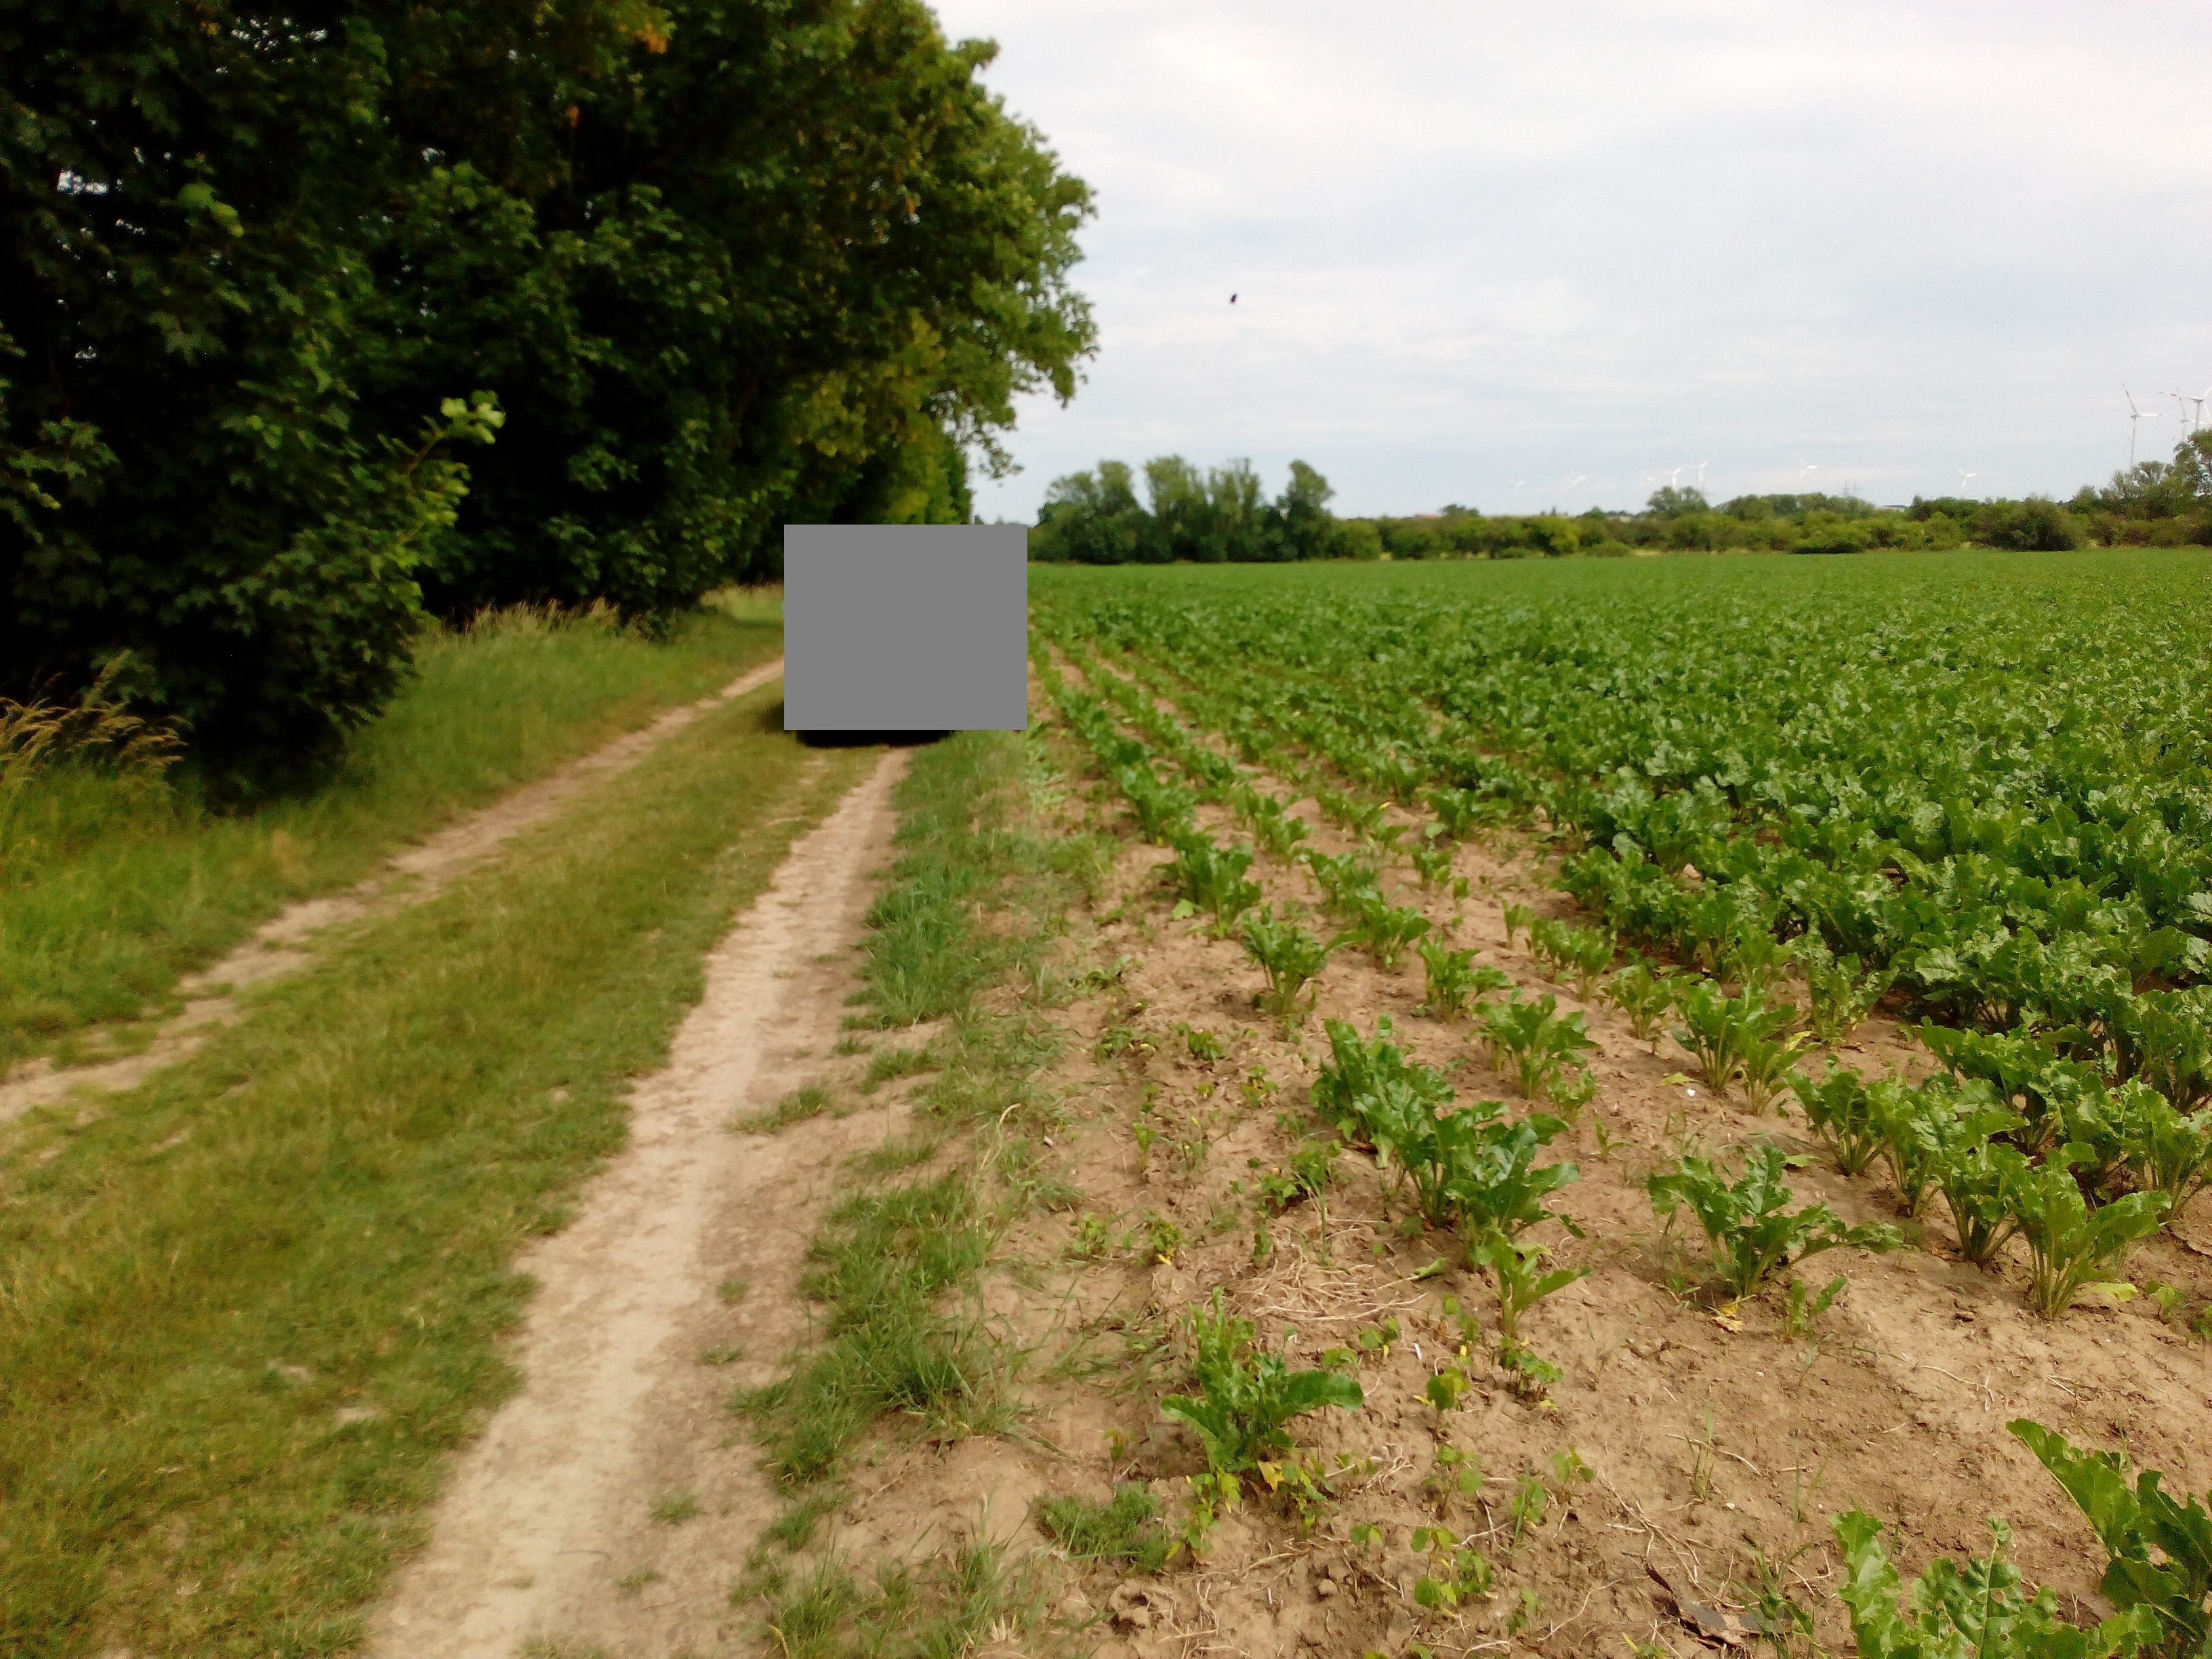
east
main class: Cropland
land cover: Sugar beet
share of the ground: > 75 %
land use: Agriculture (excluding fallow land and kitchen gardens)
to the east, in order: Sugar beet
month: June
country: DE
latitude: 51.2233
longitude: 10.9305
